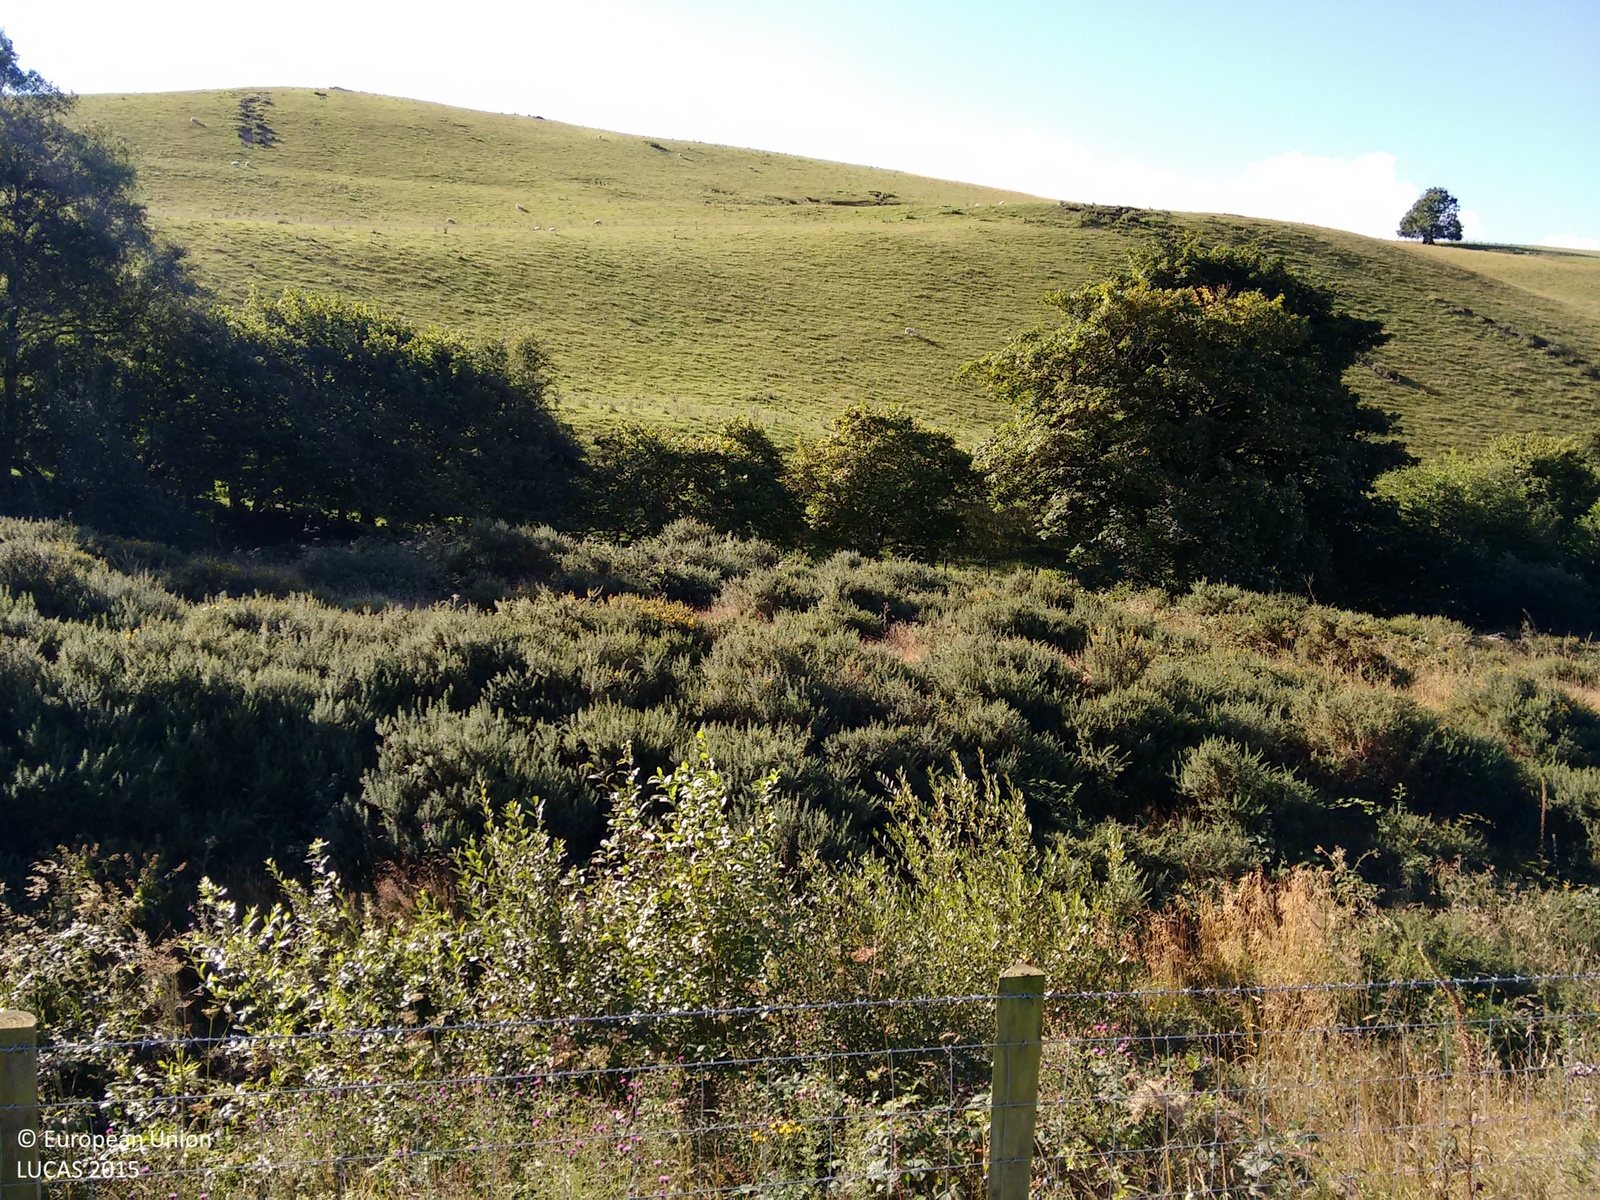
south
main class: Grassland
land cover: Grassland without tree/shrub cover
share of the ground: > 75 %
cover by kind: herbaceous plants 100 %
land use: Agriculture (excluding fallow land and kitchen gardens)
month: August
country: GB
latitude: 53.2020
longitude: -3.5433
